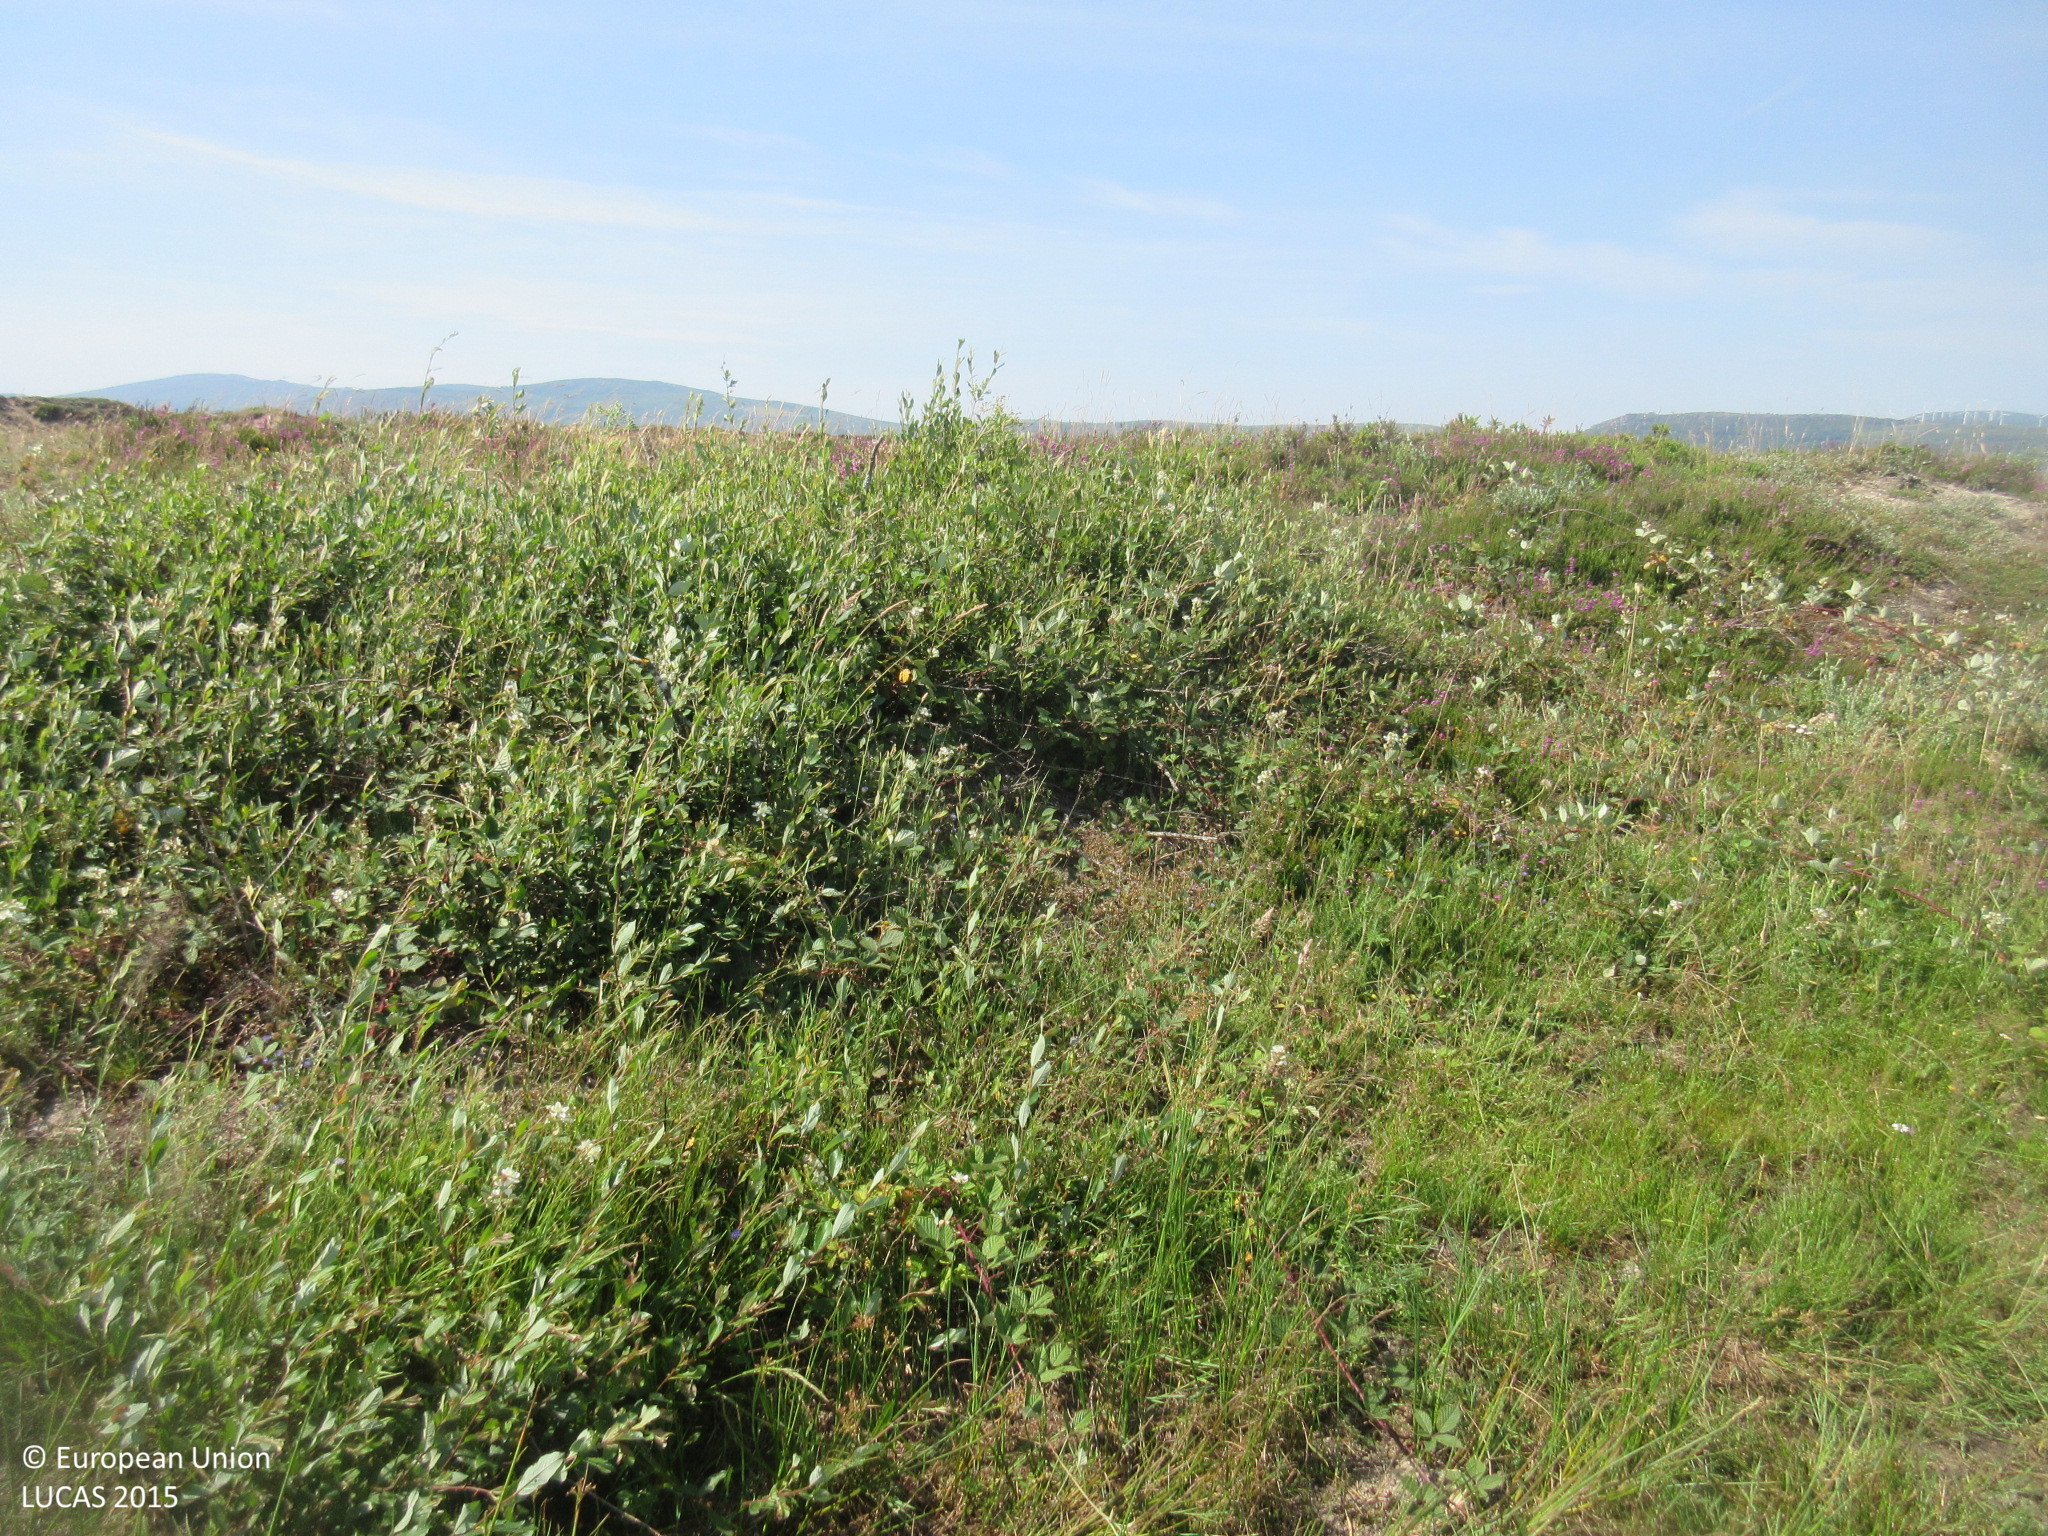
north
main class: Grassland
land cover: Grassland without tree/shrub cover
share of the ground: > 75 %
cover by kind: herbaceous plants 100 %
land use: Agriculture (excluding fallow land and kitchen gardens)
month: July
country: ES
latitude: 42.9935
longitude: -3.8688
